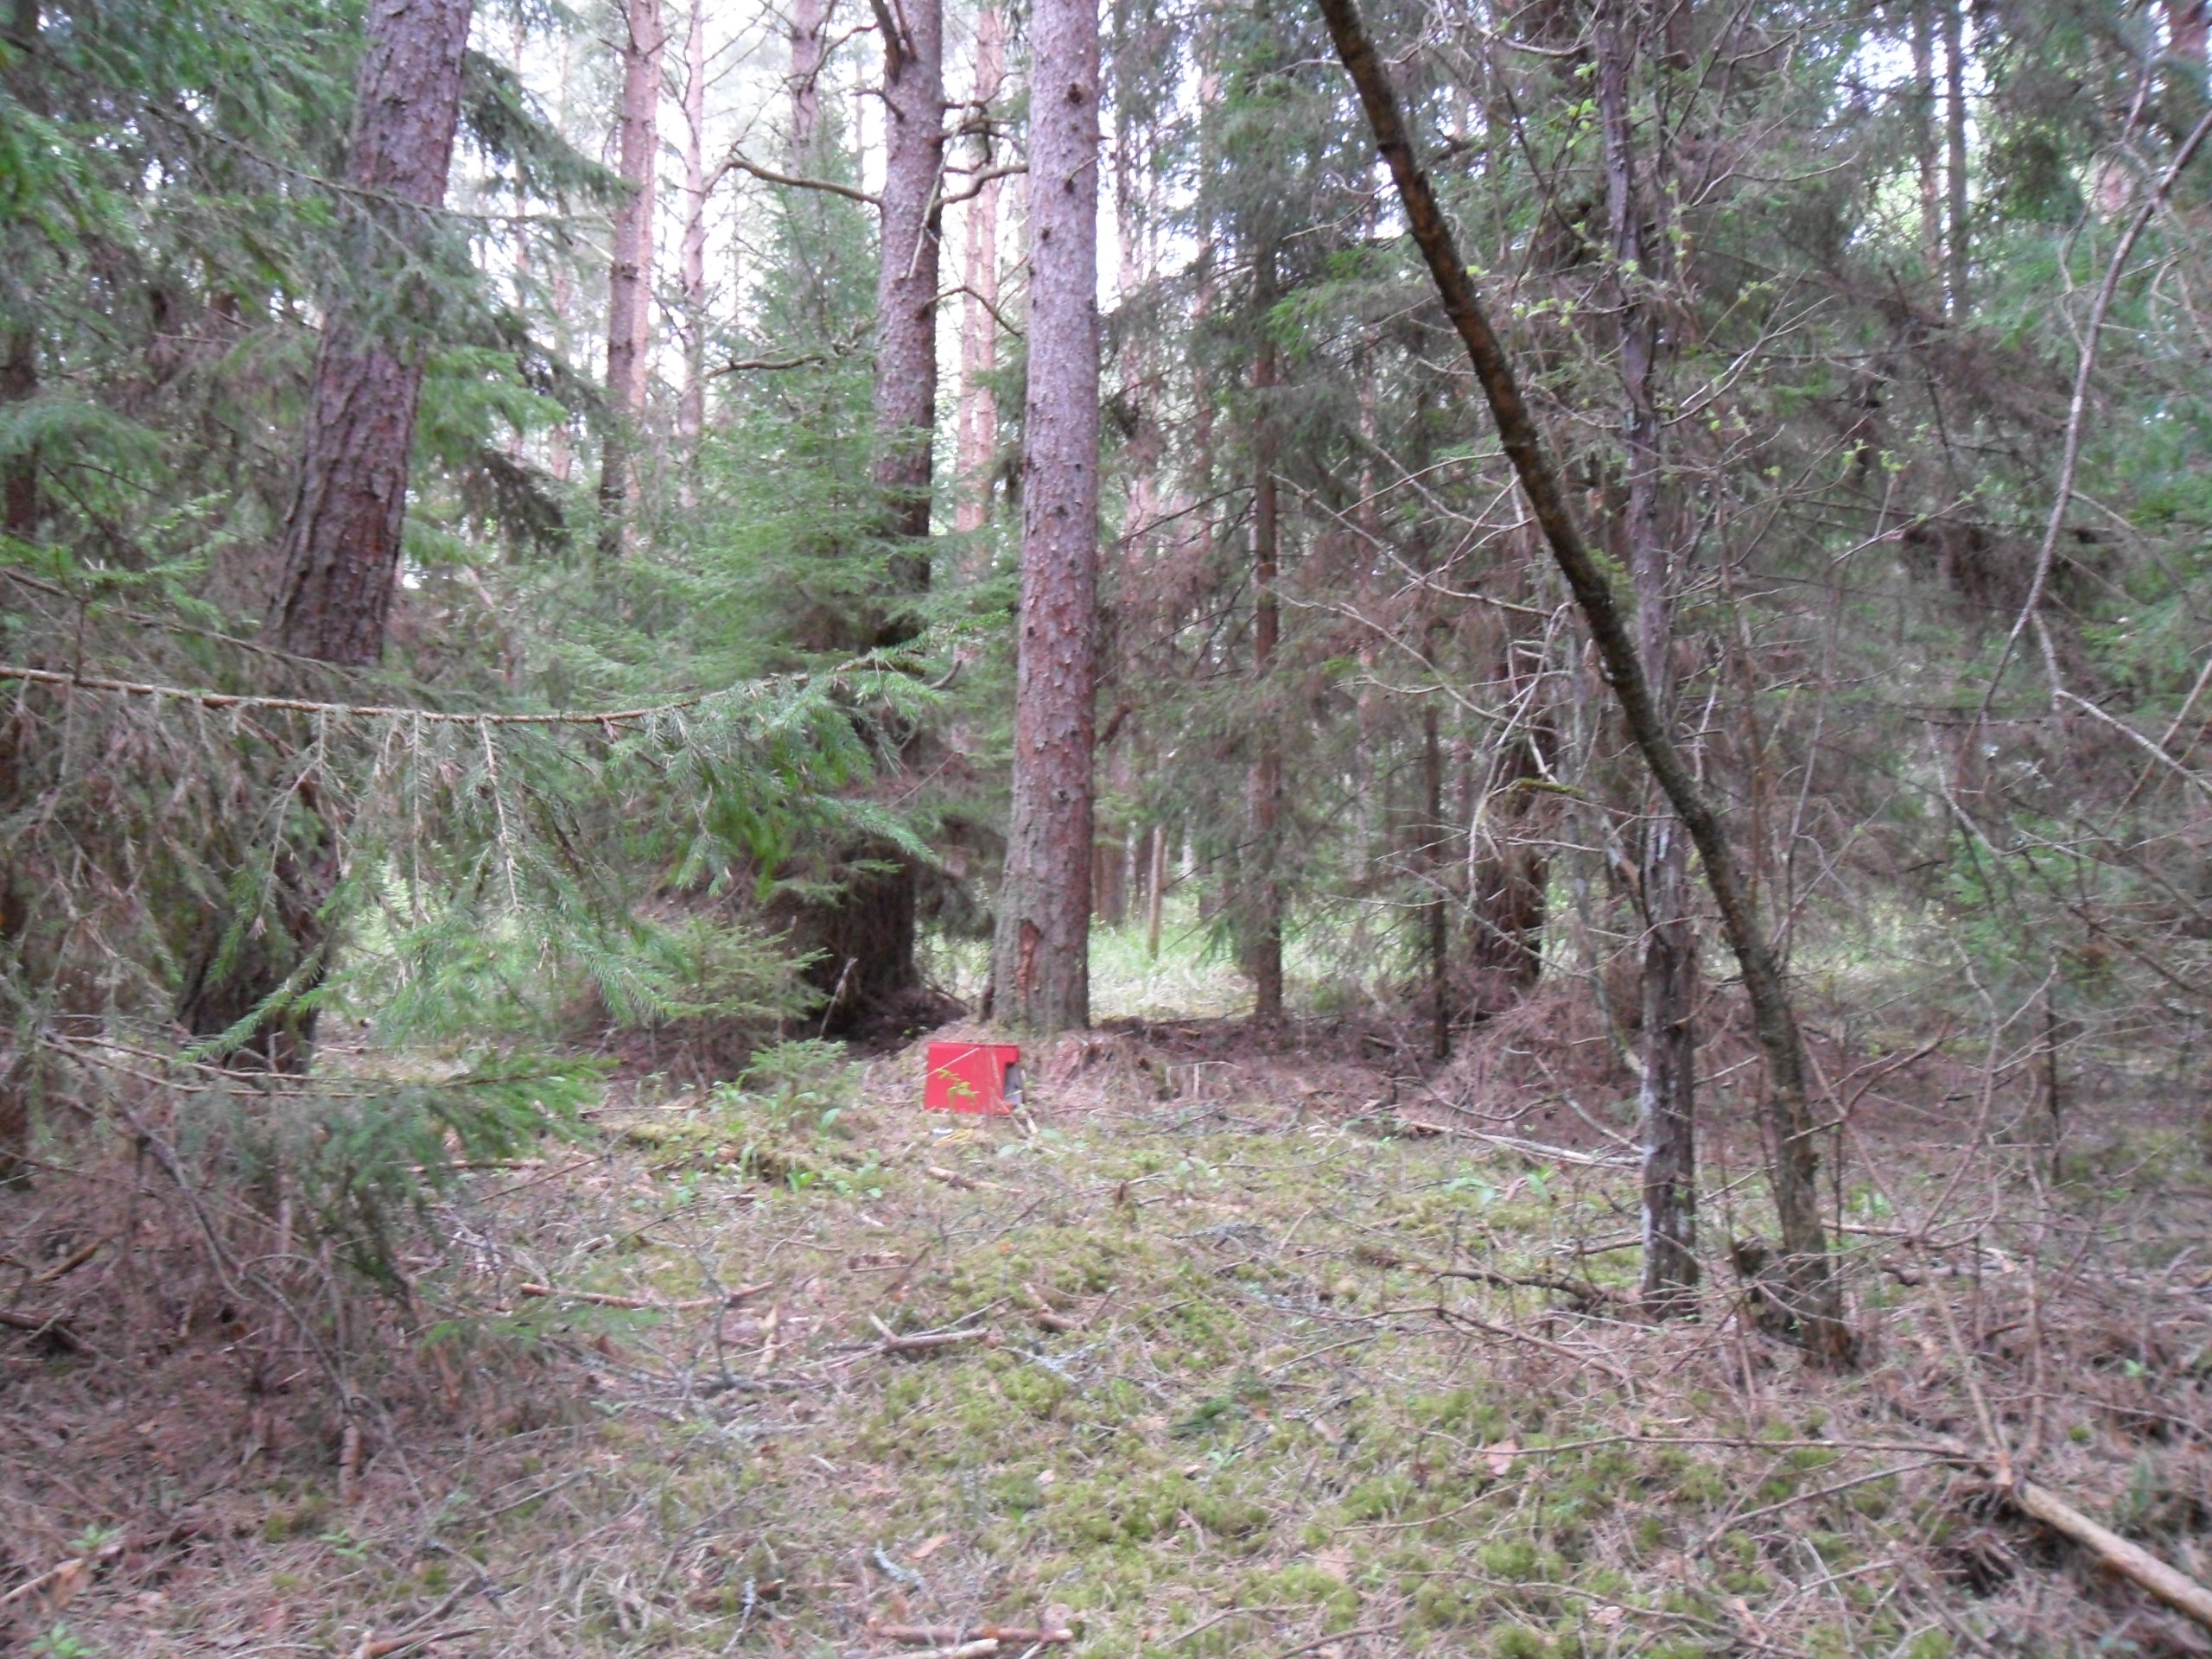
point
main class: Woodland
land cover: Other coniferous woodland
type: hemiboreal forest and nemoral coniferous forest and mixed broadleaved-coniferous forest
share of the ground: > 75 %
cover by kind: coniferous forest trees 100 %
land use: Forestry
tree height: > 5 m
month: May
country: LV
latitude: 57.2342
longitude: 23.0350
